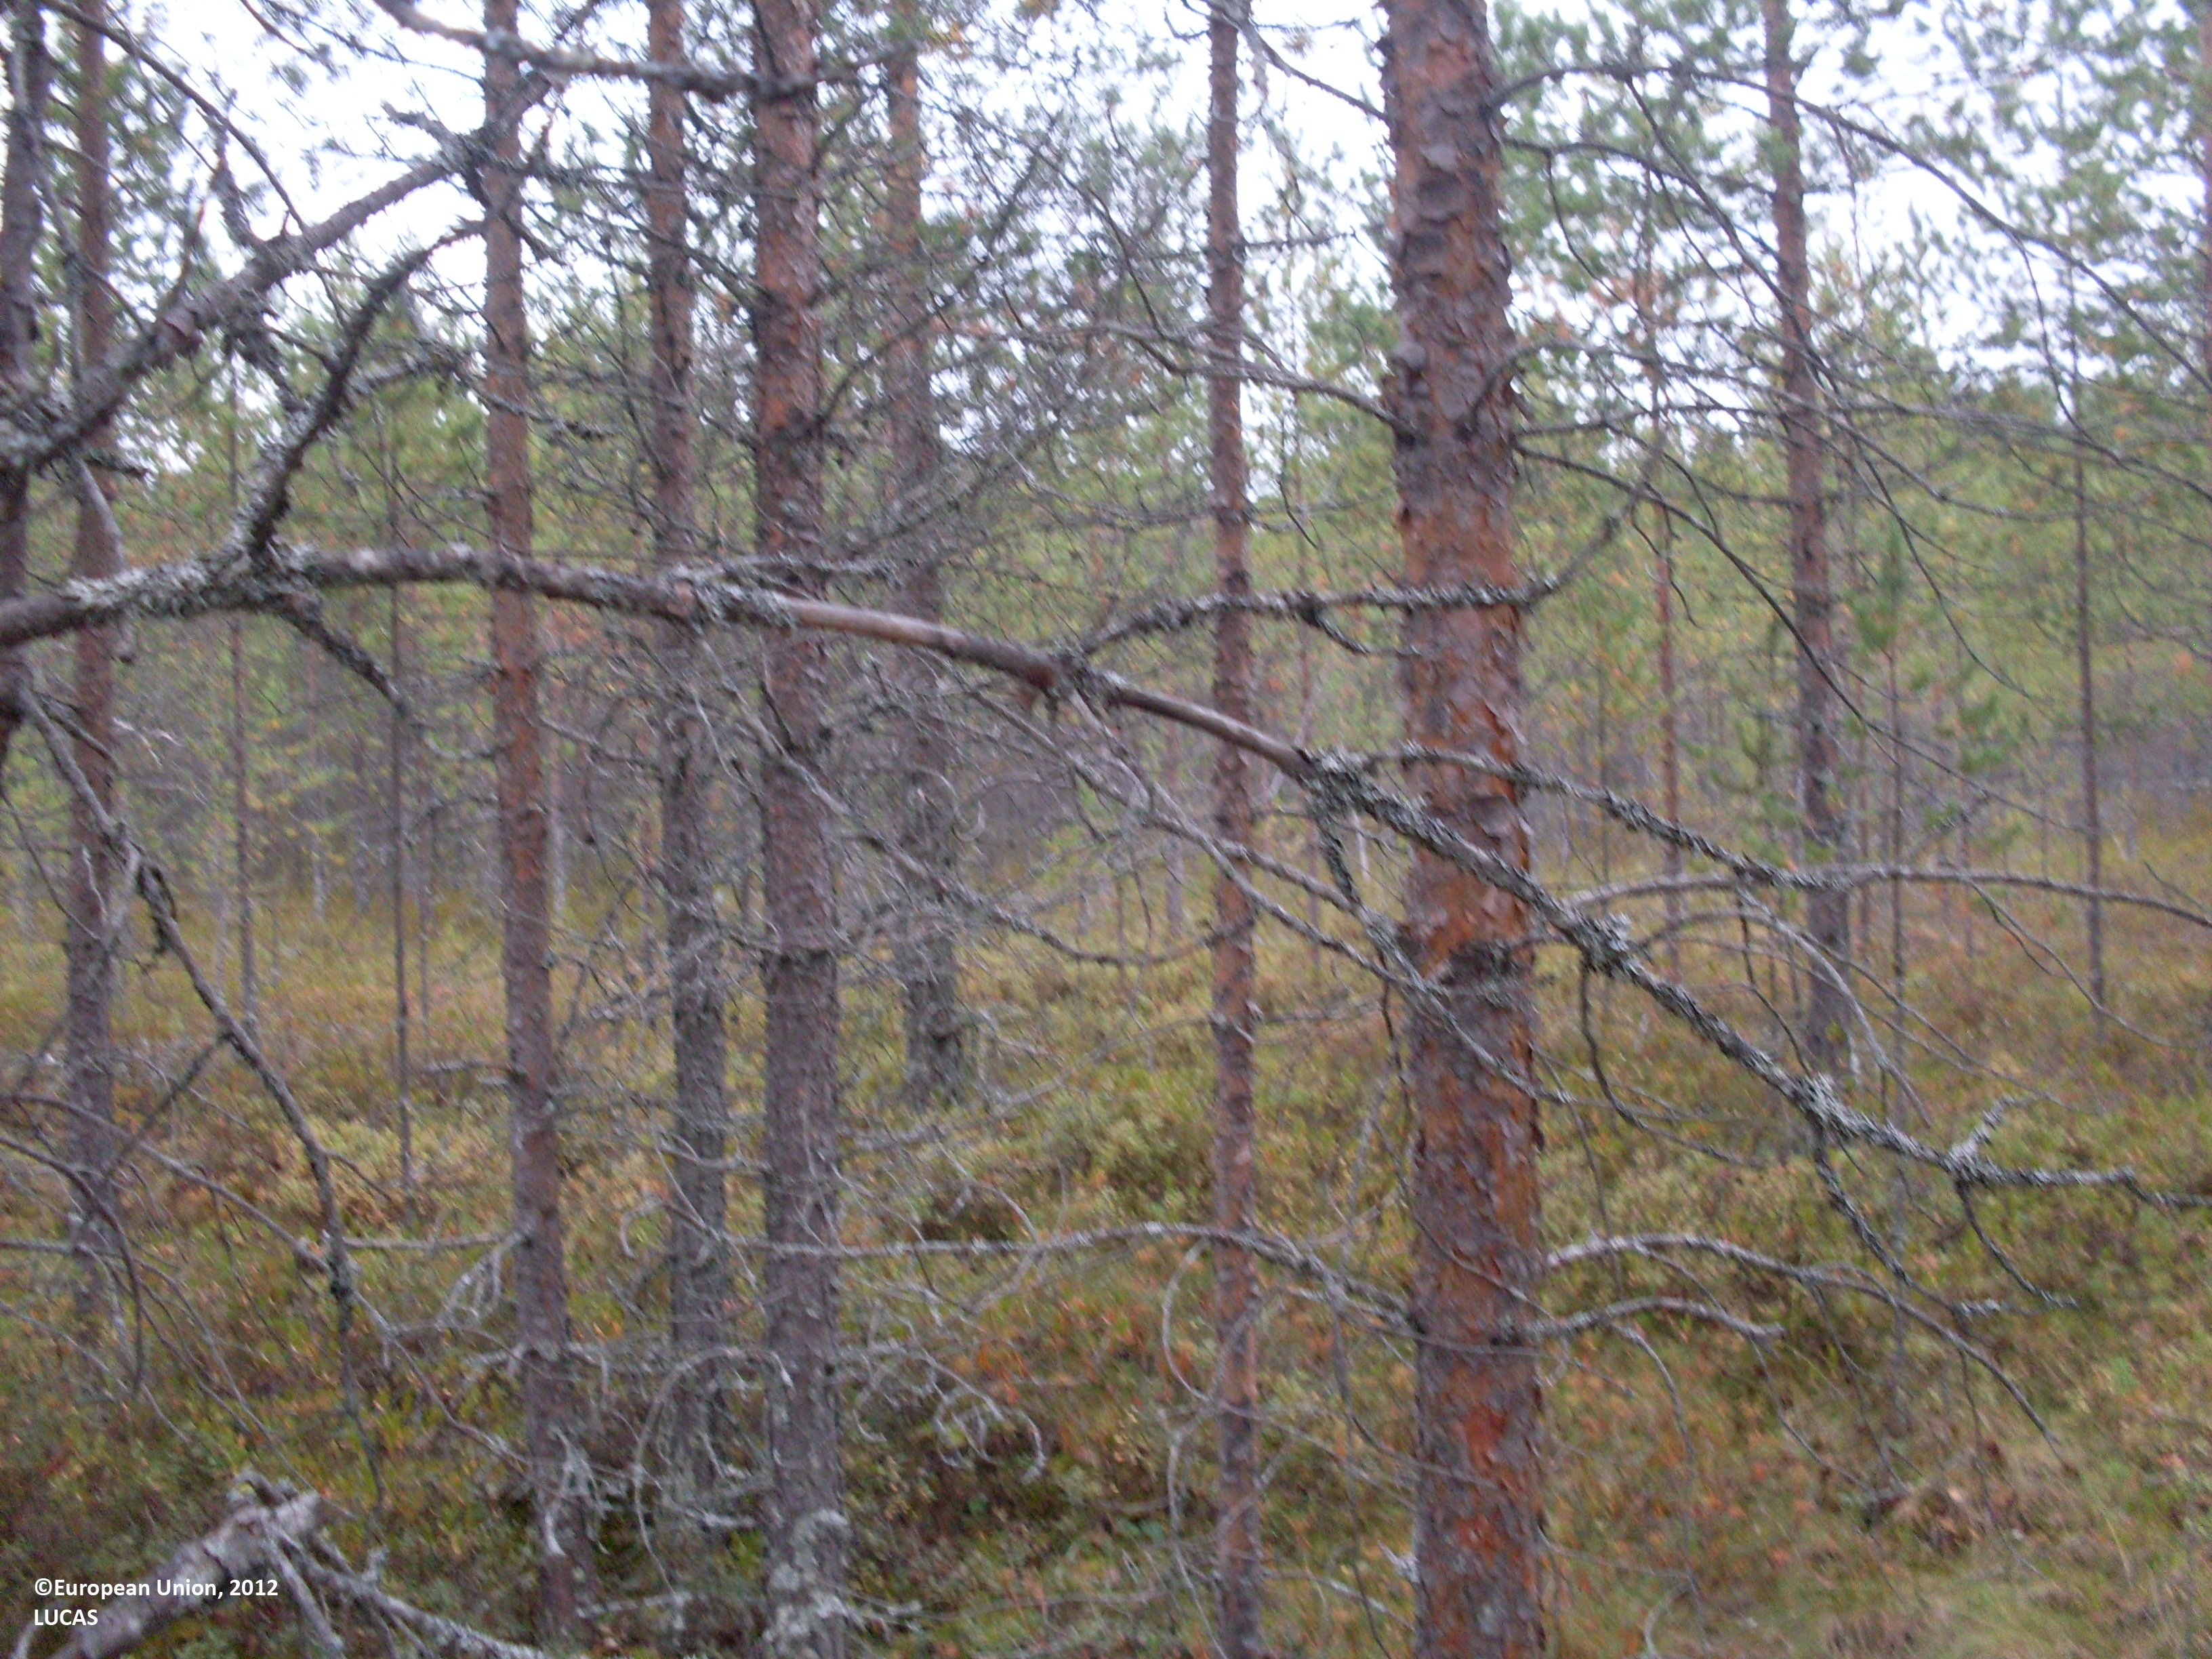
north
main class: Woodland
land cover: Pine dominated coniferous woodland
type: boreal forest
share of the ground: 50 - 75 %
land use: Forestry
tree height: > 5 m
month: September
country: FI
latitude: 64.1504
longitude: 29.4360
